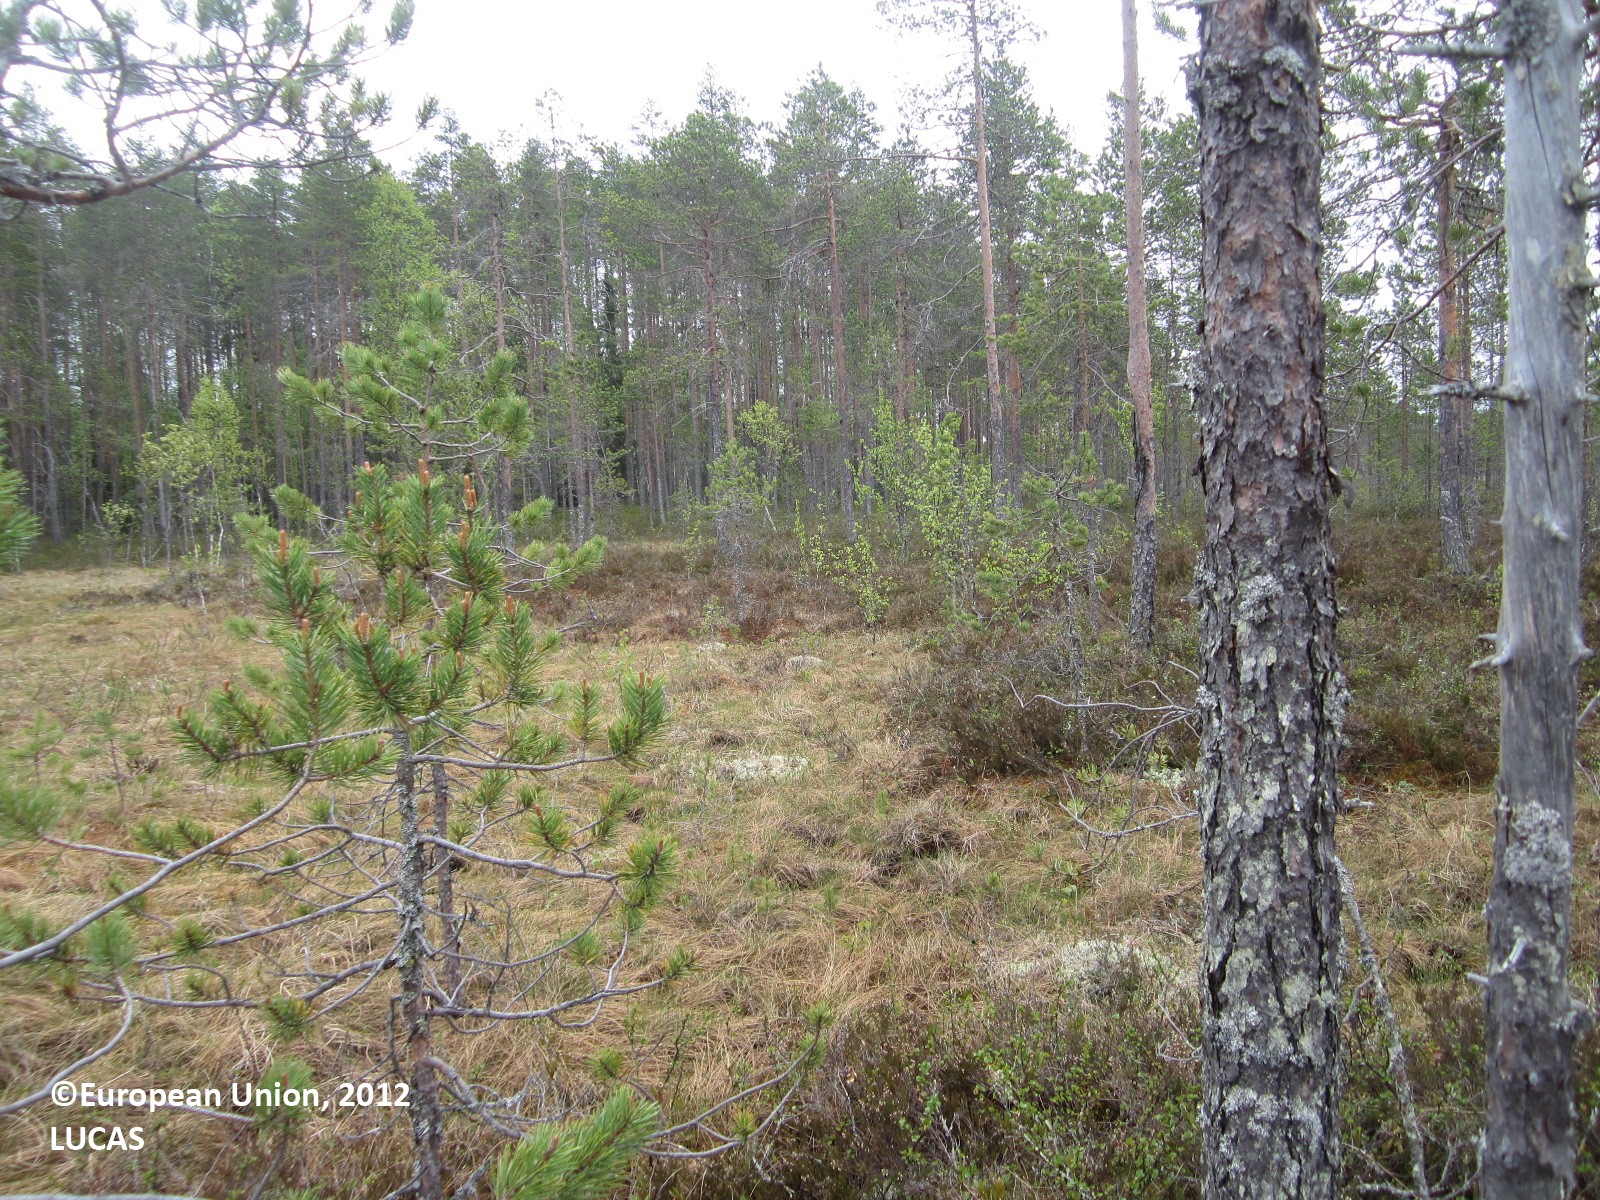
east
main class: Woodland
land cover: Pine dominated coniferous woodland
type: mire and swamp forests
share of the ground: 10 - 25 %
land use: Semi-natural and natural areas not in use
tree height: > 5 m
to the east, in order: Pine dominated coniferous woodland; Peatbogs; Pine dominated coniferous woodland; Peatbogs; Pine dominated coniferous woodland; Pine dominated mixed woodland; Shrubland with sparse tree cover; Spruce dominated mixed woodland; Shrubland with sparse tree cover; Other mixed woodland; Ditches and canals; Grassland with sparse tree/shrub cover; Peatbogs; Pine dominated mixed woodland
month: June
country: FI
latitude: 64.6834
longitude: 28.6000
